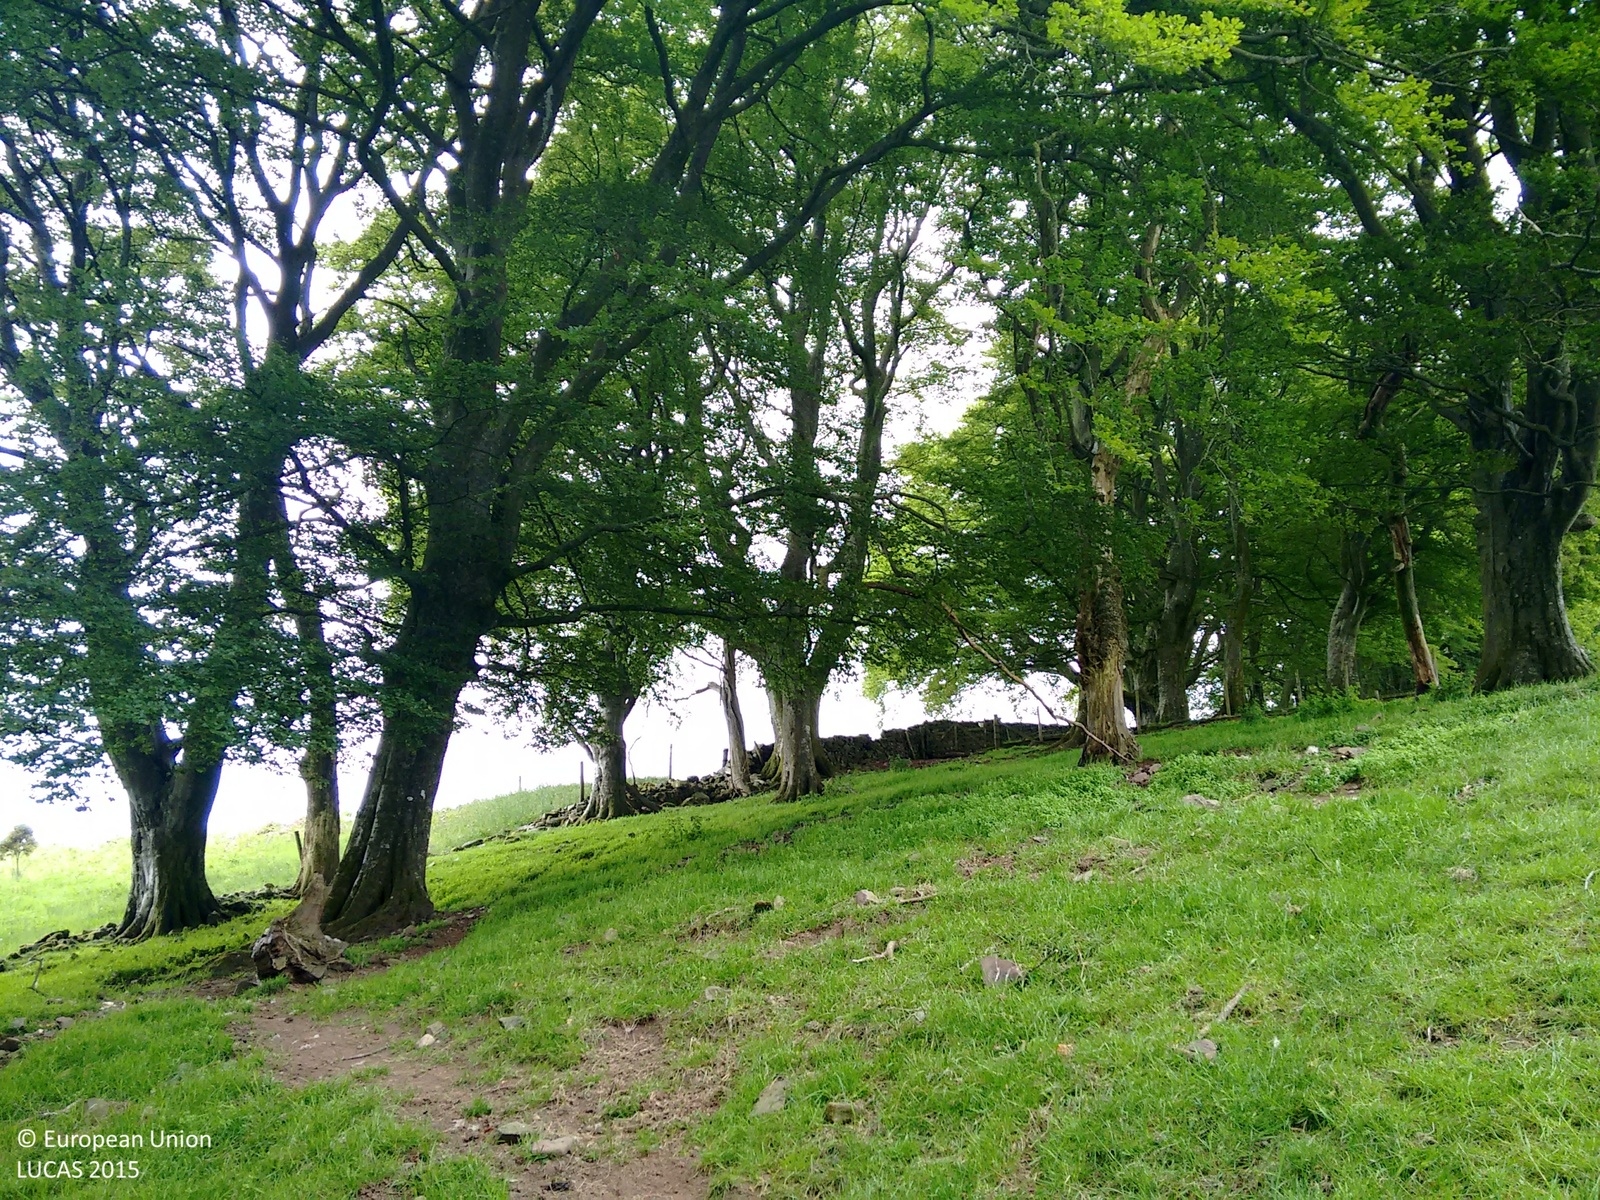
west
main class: Woodland
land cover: Broadleaved woodland
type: mesophytic deciduous forest
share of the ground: > 75 %
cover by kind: broadleaved forest trees 80 %, herbaceous plants 20 %
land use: Agriculture (excluding fallow land and kitchen gardens)
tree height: > 5 m
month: June
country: GB
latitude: 55.1921
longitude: -3.7031
